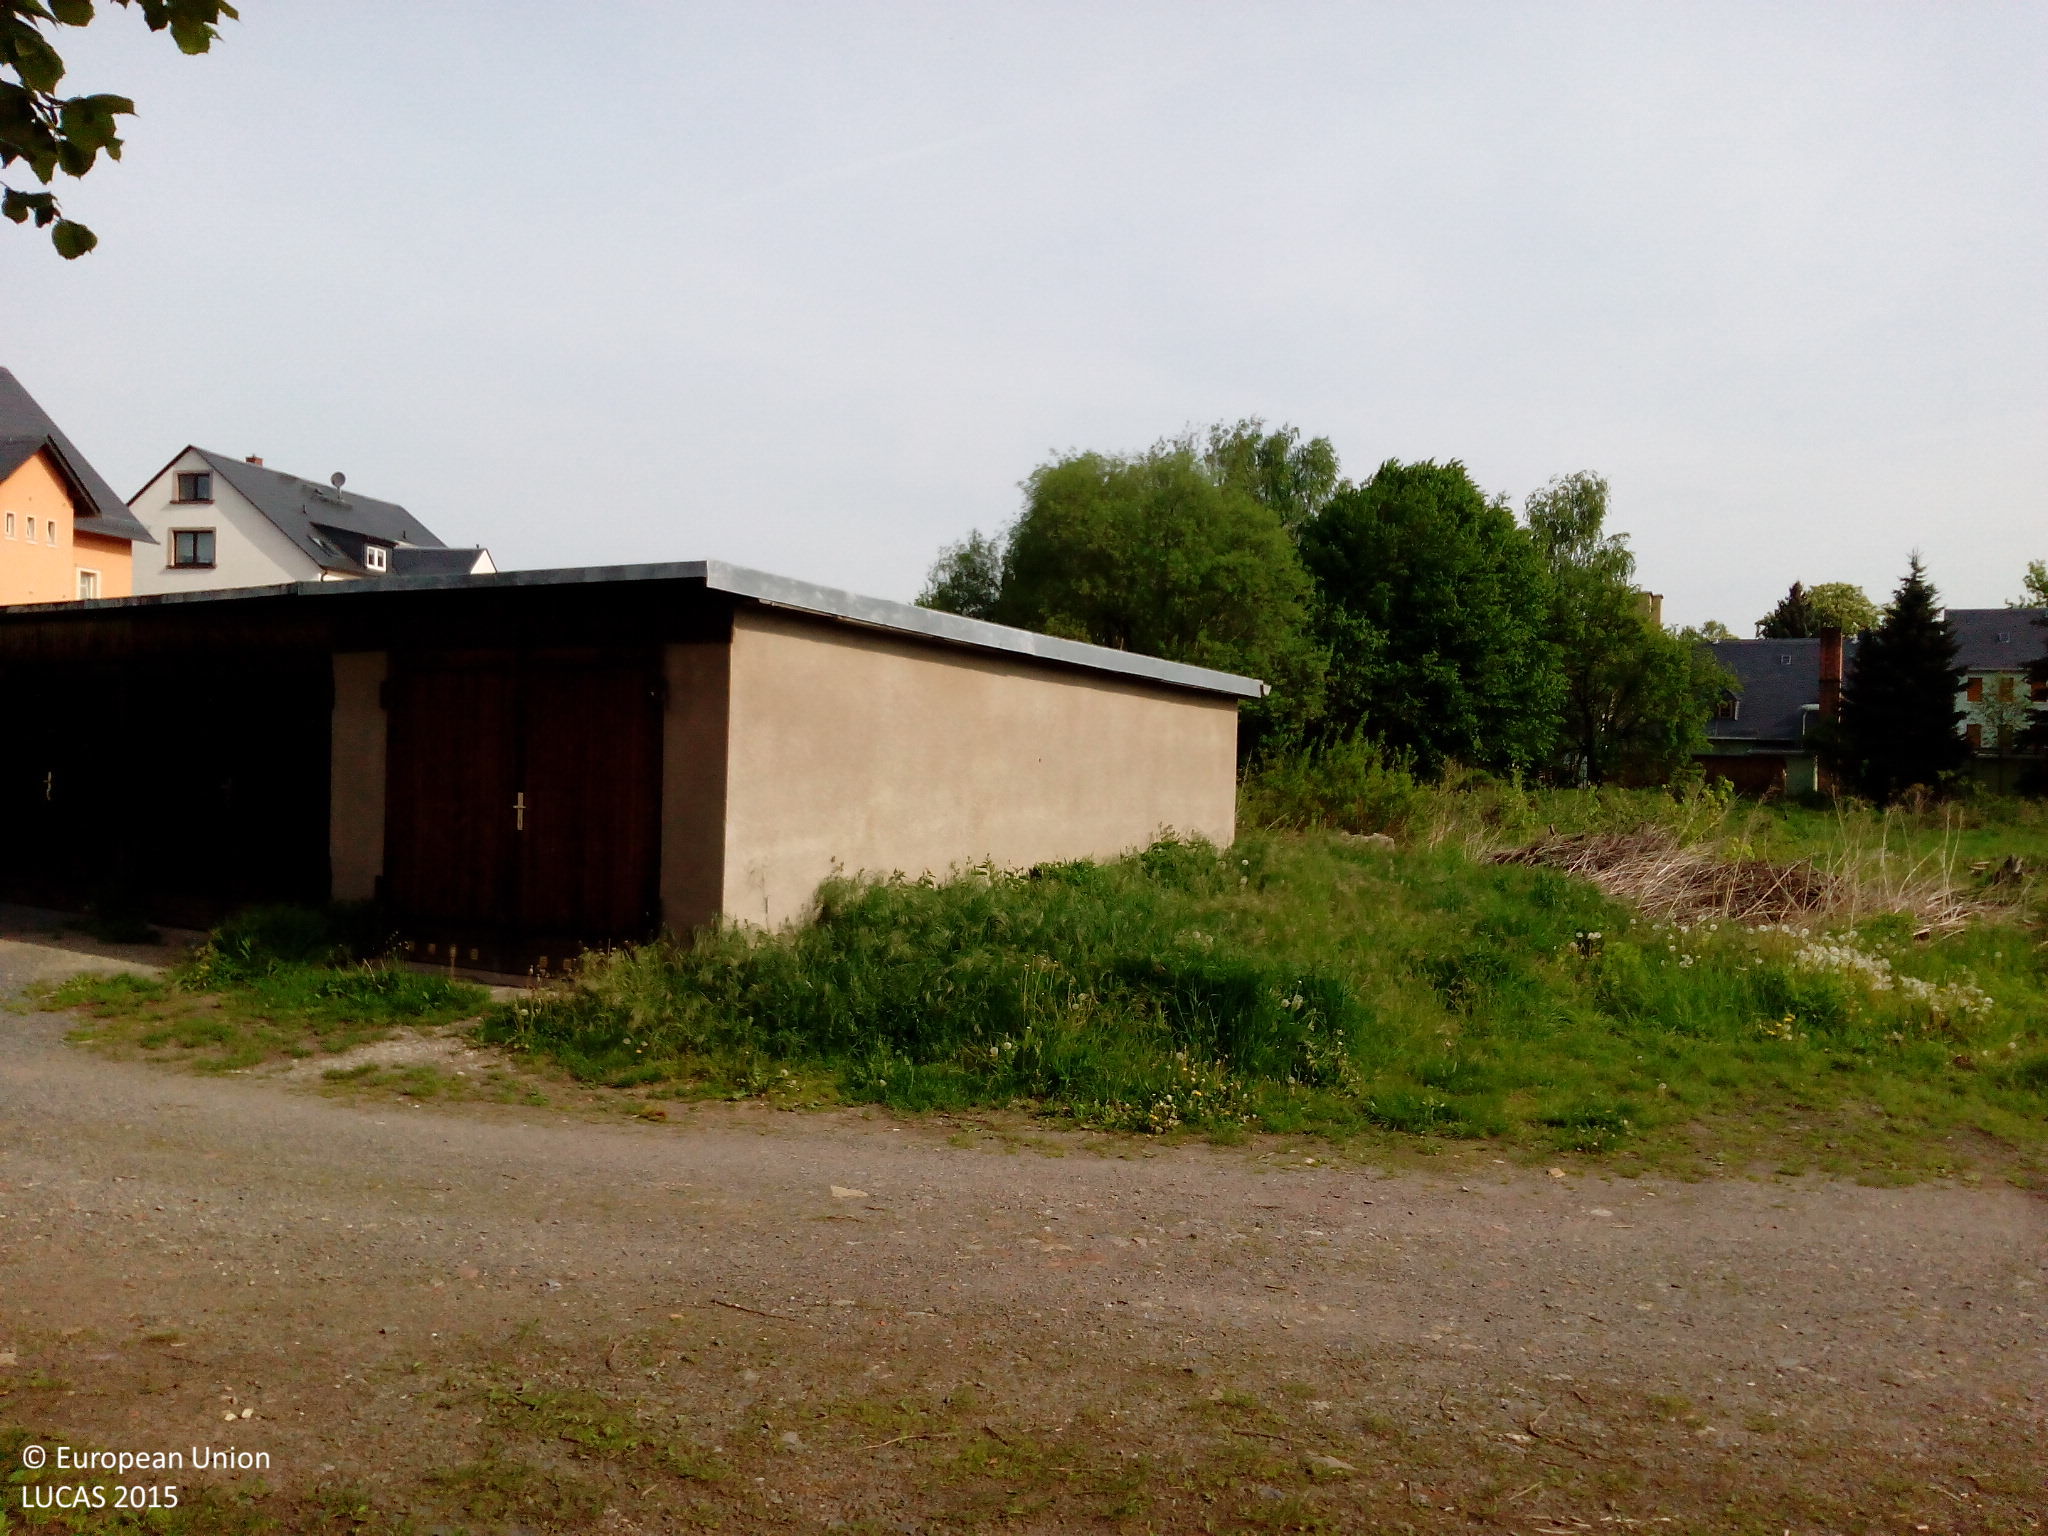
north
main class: Woodland
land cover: Broadleaved woodland
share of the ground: 10 - 25 %
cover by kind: consolidated bare surface 55 %, herbaceous plants 25 %, broadleaved forest trees 20 %
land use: Residential
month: May
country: DE
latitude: 50.8444
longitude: 13.0819
